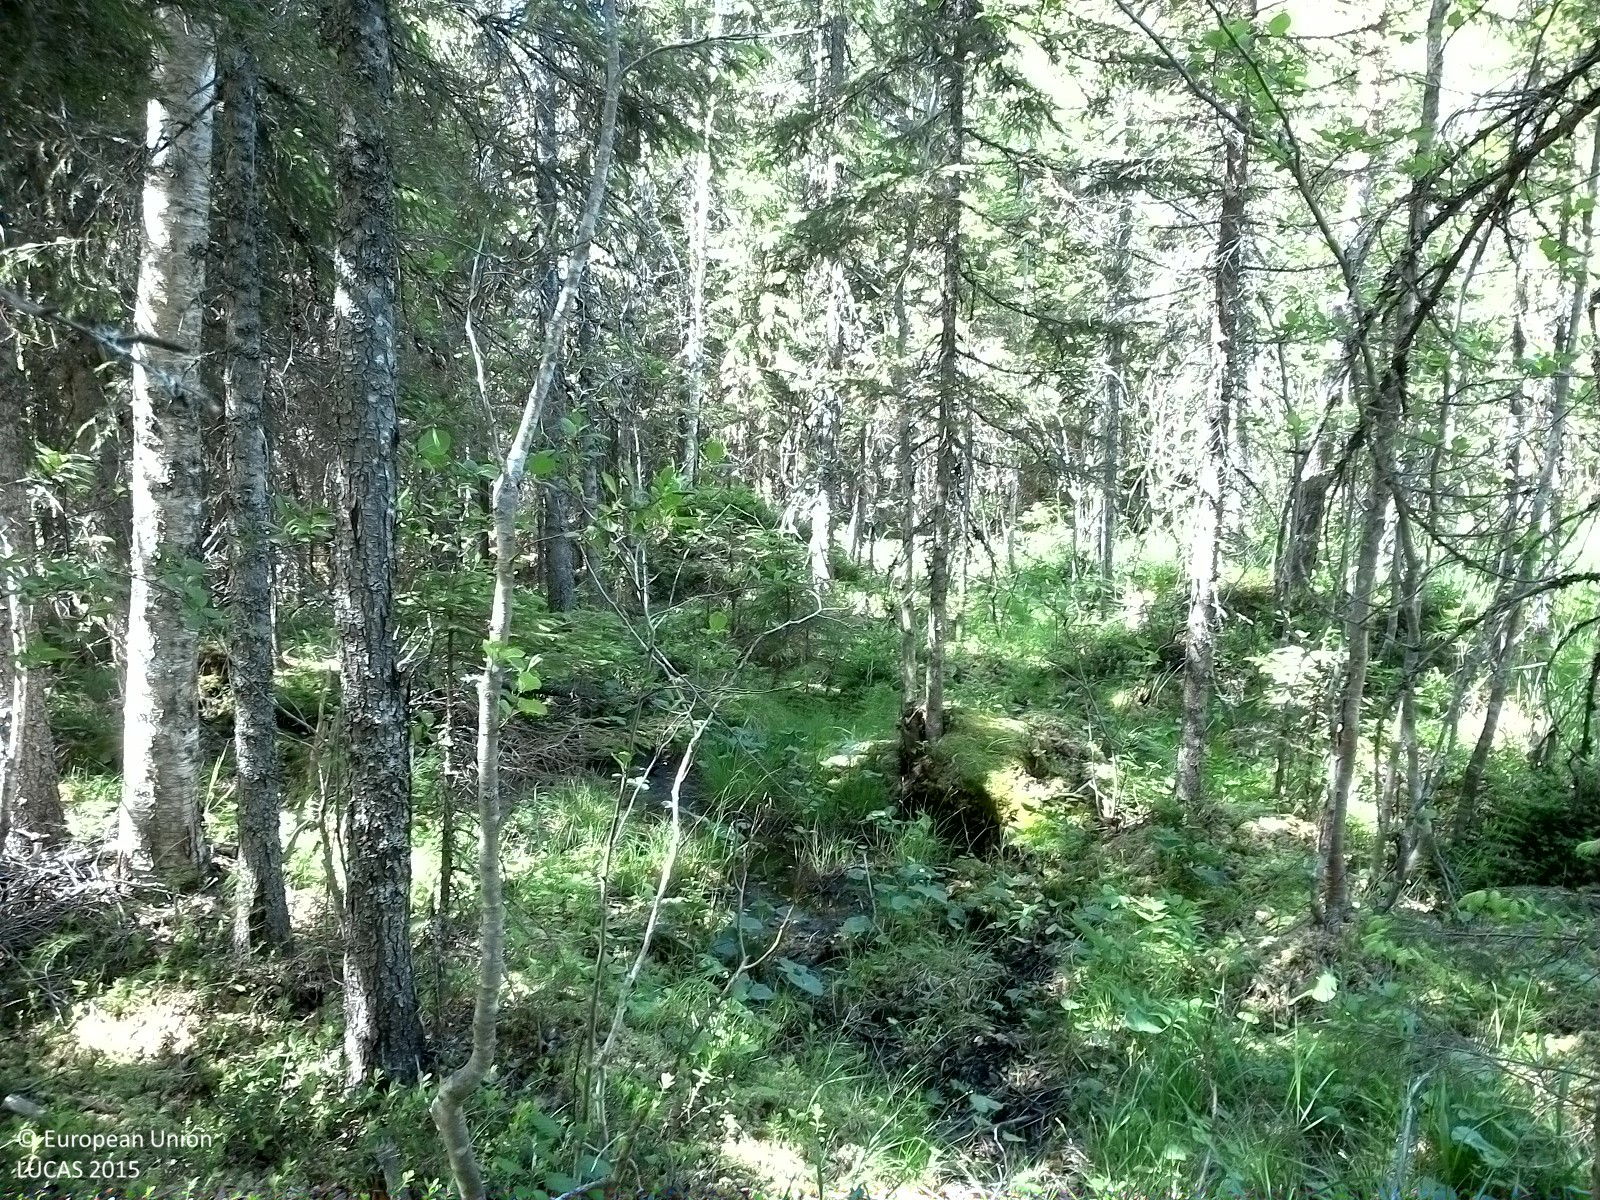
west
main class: Woodland
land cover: Spruce dominated mixed woodland
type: boreal forest
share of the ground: 50 - 75 %
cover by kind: coniferous forest trees 45 %, shrubs 30 %, broadleaved forest trees 15 %, herbaceous plants 10 %
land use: Forestry
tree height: > 5 m
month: July
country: SE
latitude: 62.2535
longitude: 16.9314
